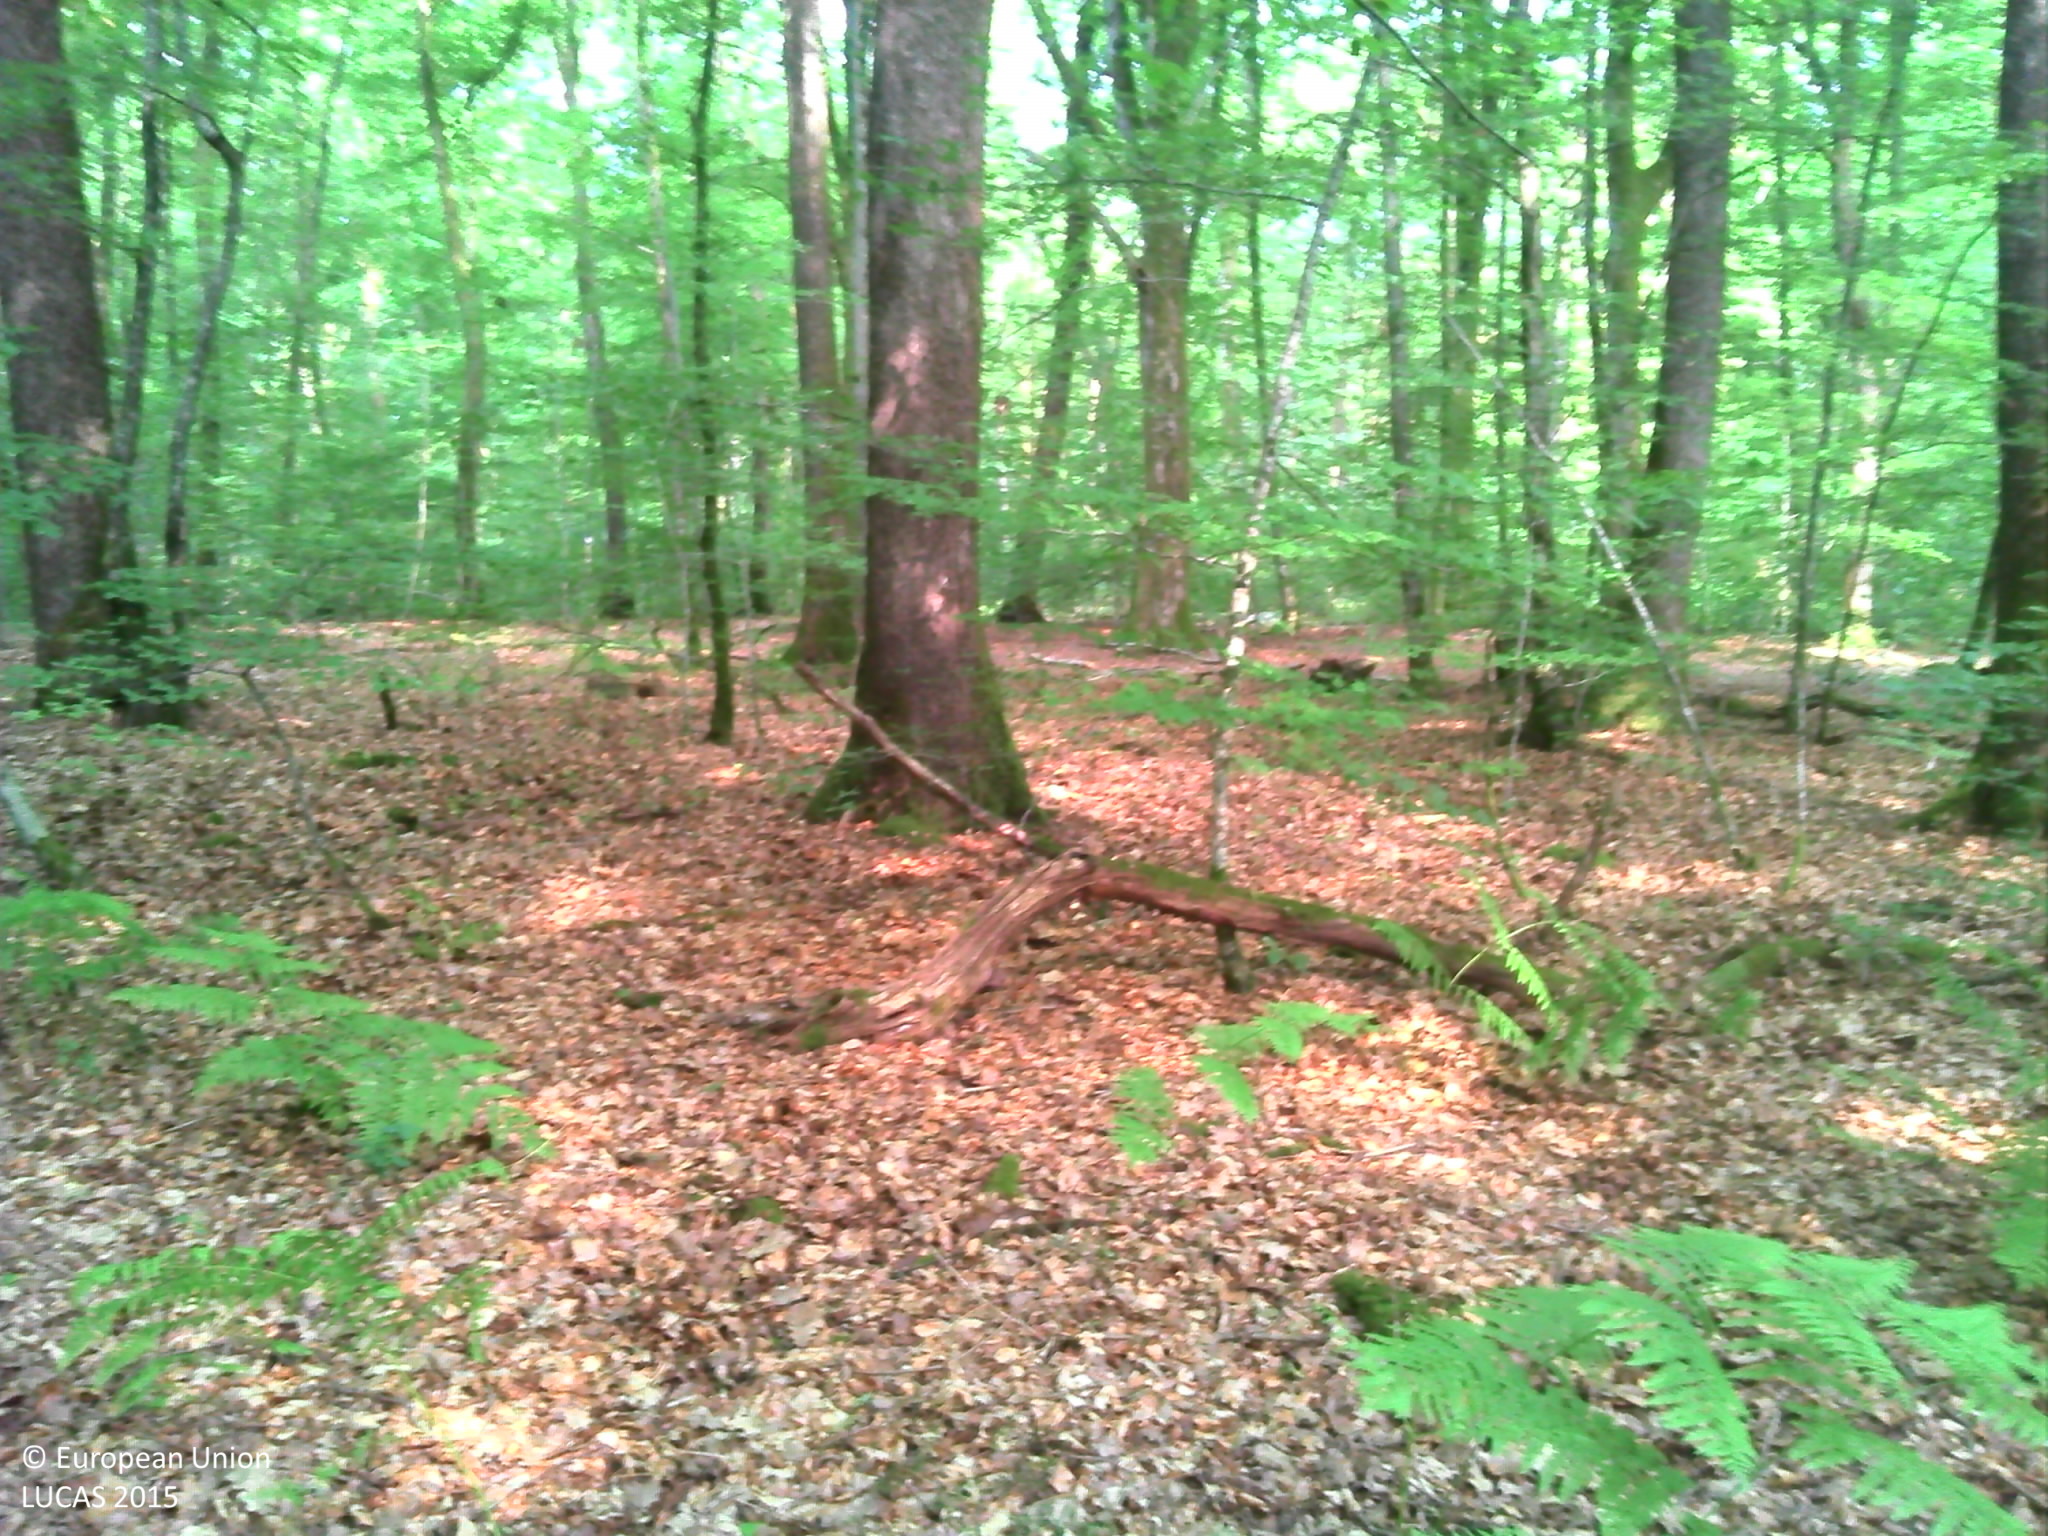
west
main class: Woodland
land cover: Broadleaved woodland
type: beech forest
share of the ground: > 75 %
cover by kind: broadleaved forest trees 95 %, herbaceous plants 5 %
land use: Forestry
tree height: > 5 m
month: June
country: FR
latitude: 47.8308
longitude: 6.1134
